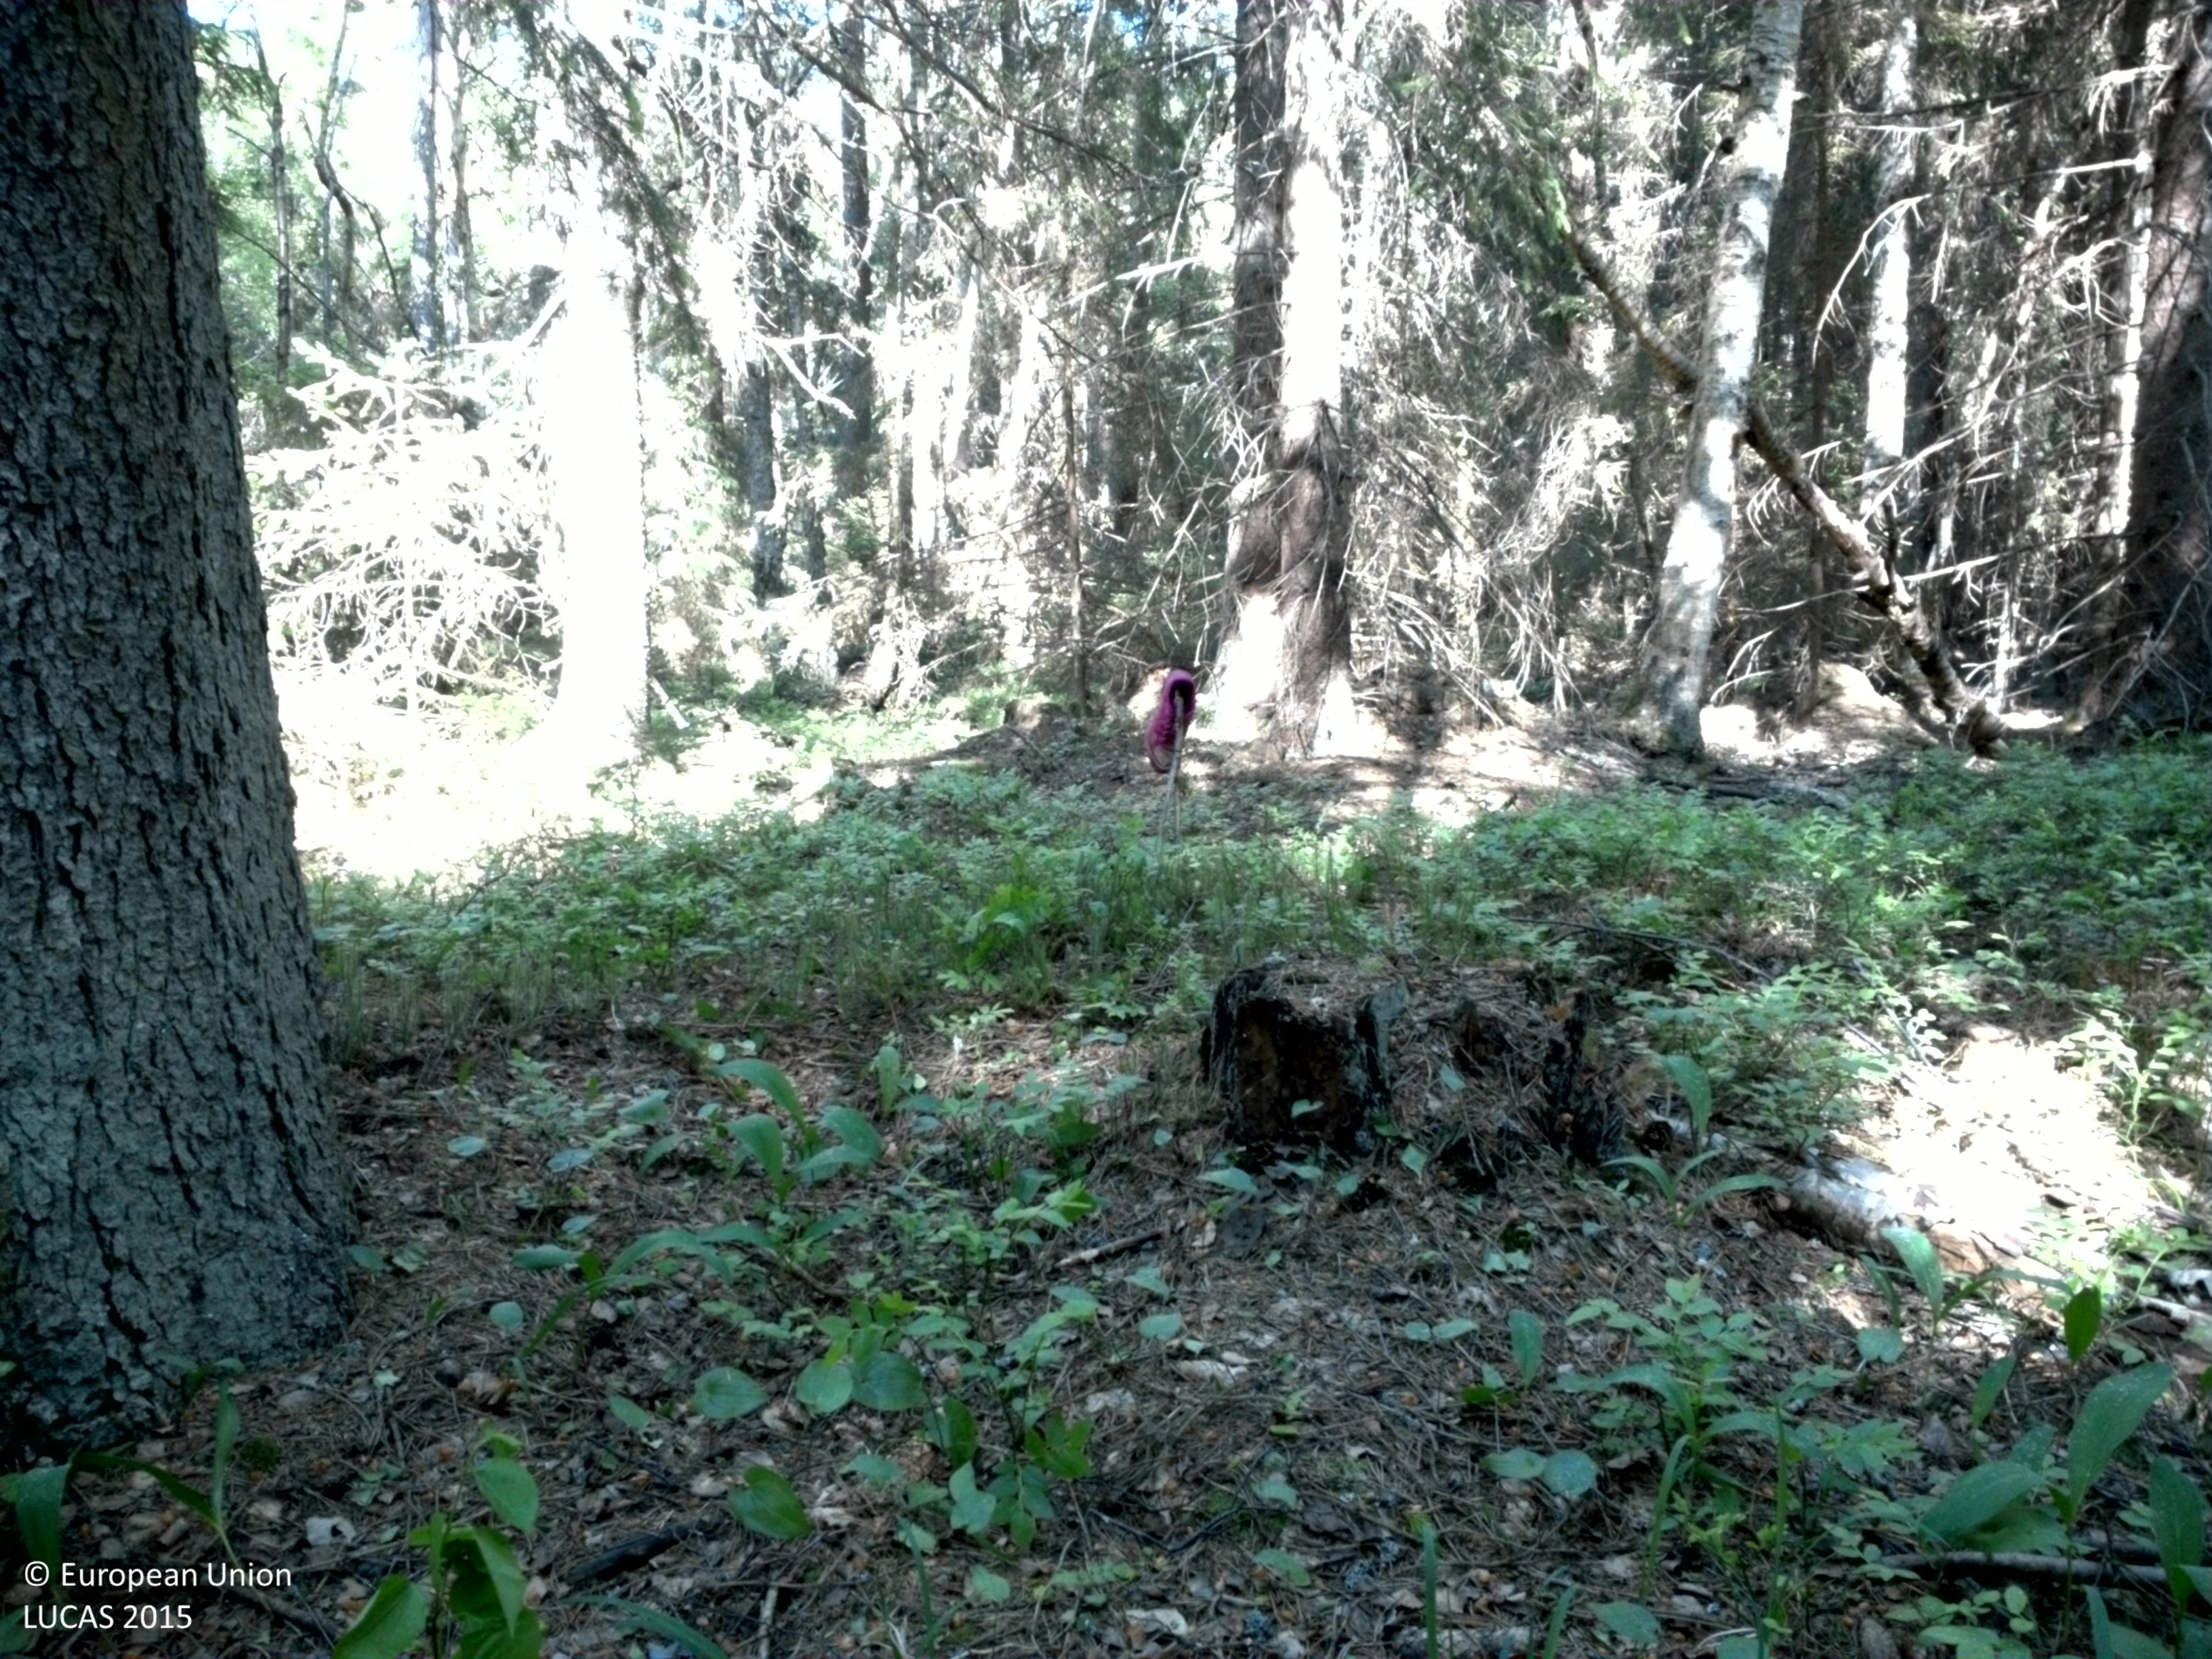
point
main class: Woodland
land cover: Spruce dominated mixed woodland
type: boreal forest
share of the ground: > 75 %
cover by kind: coniferous forest trees 60 %, broadleaved forest trees 20 %, shrubs 10 %, herbaceous plants 10 %
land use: Forestry
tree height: > 5 m
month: June
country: SE
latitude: 59.9736
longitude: 18.8682
